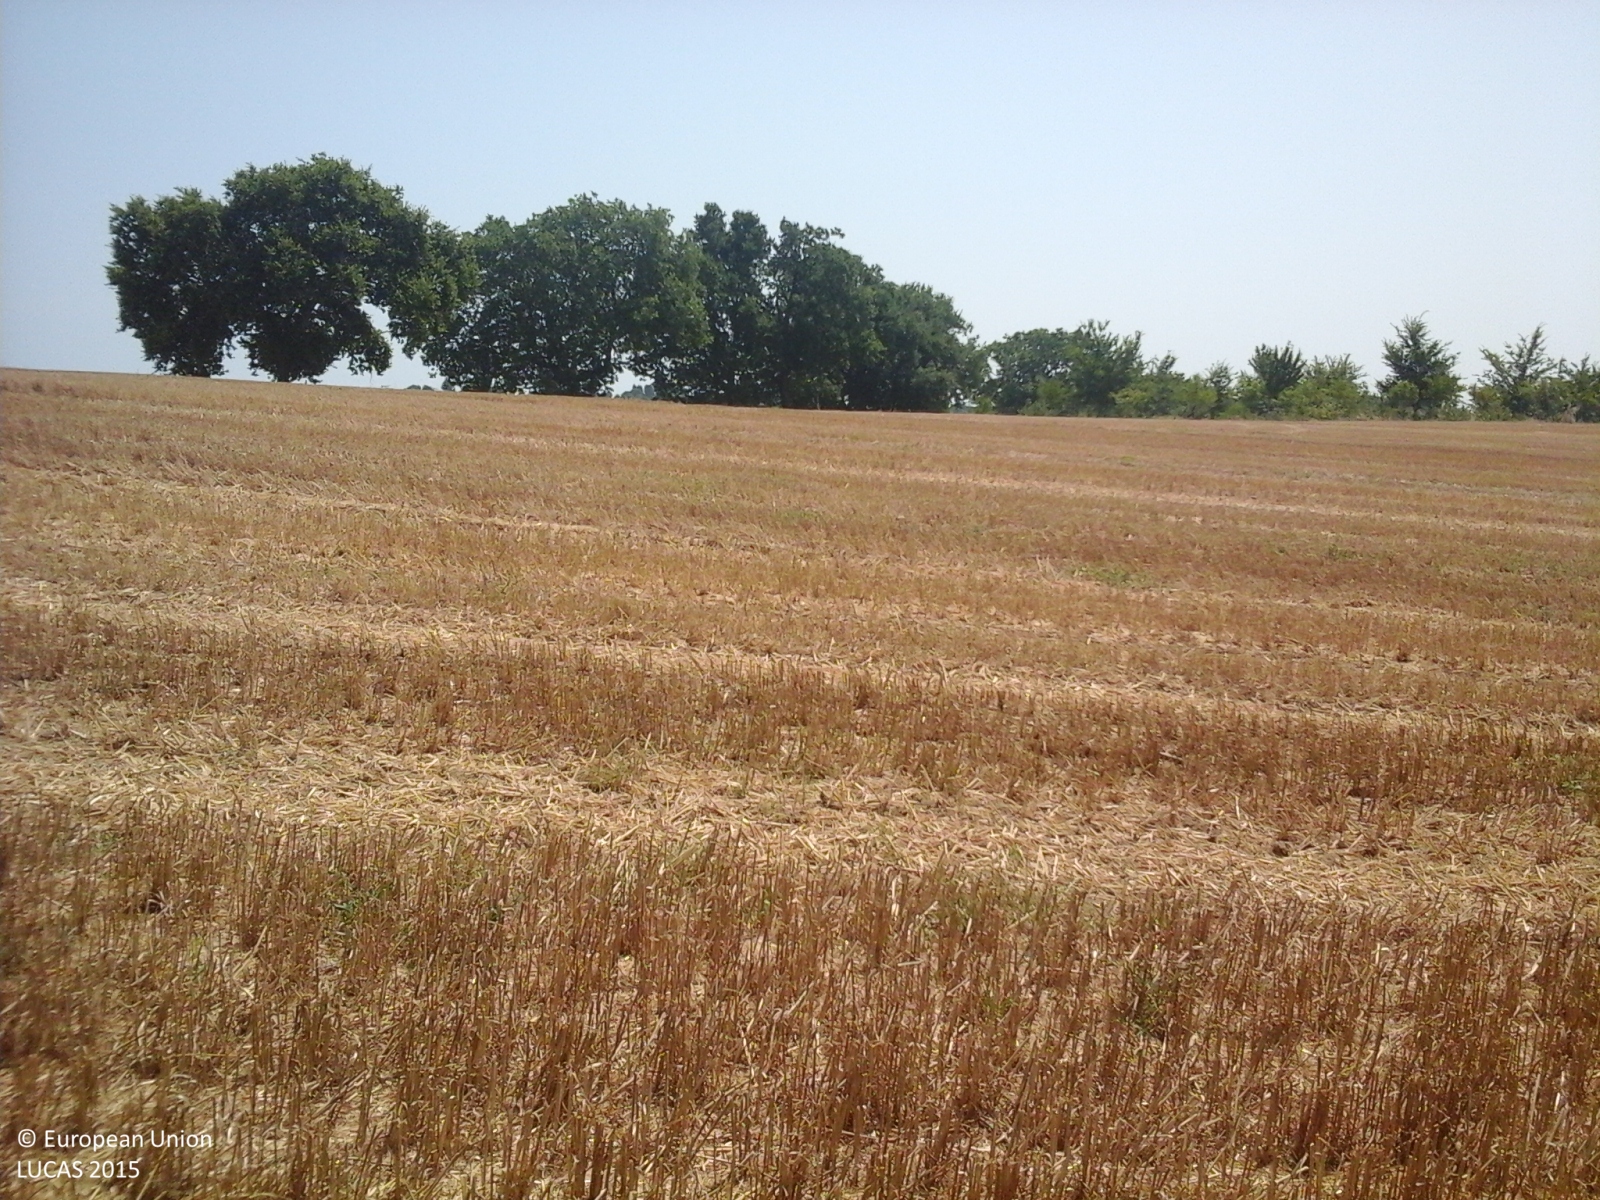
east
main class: Cropland
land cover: Durum wheat
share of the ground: > 75 %
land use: Agriculture (excluding fallow land and kitchen gardens)
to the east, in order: Abandoned hedges; Durum wheat; Lines of trees; Grass margins; Tracks; Grass margins; Durum wheat
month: July
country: IT
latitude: 43.3111
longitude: 13.6526
